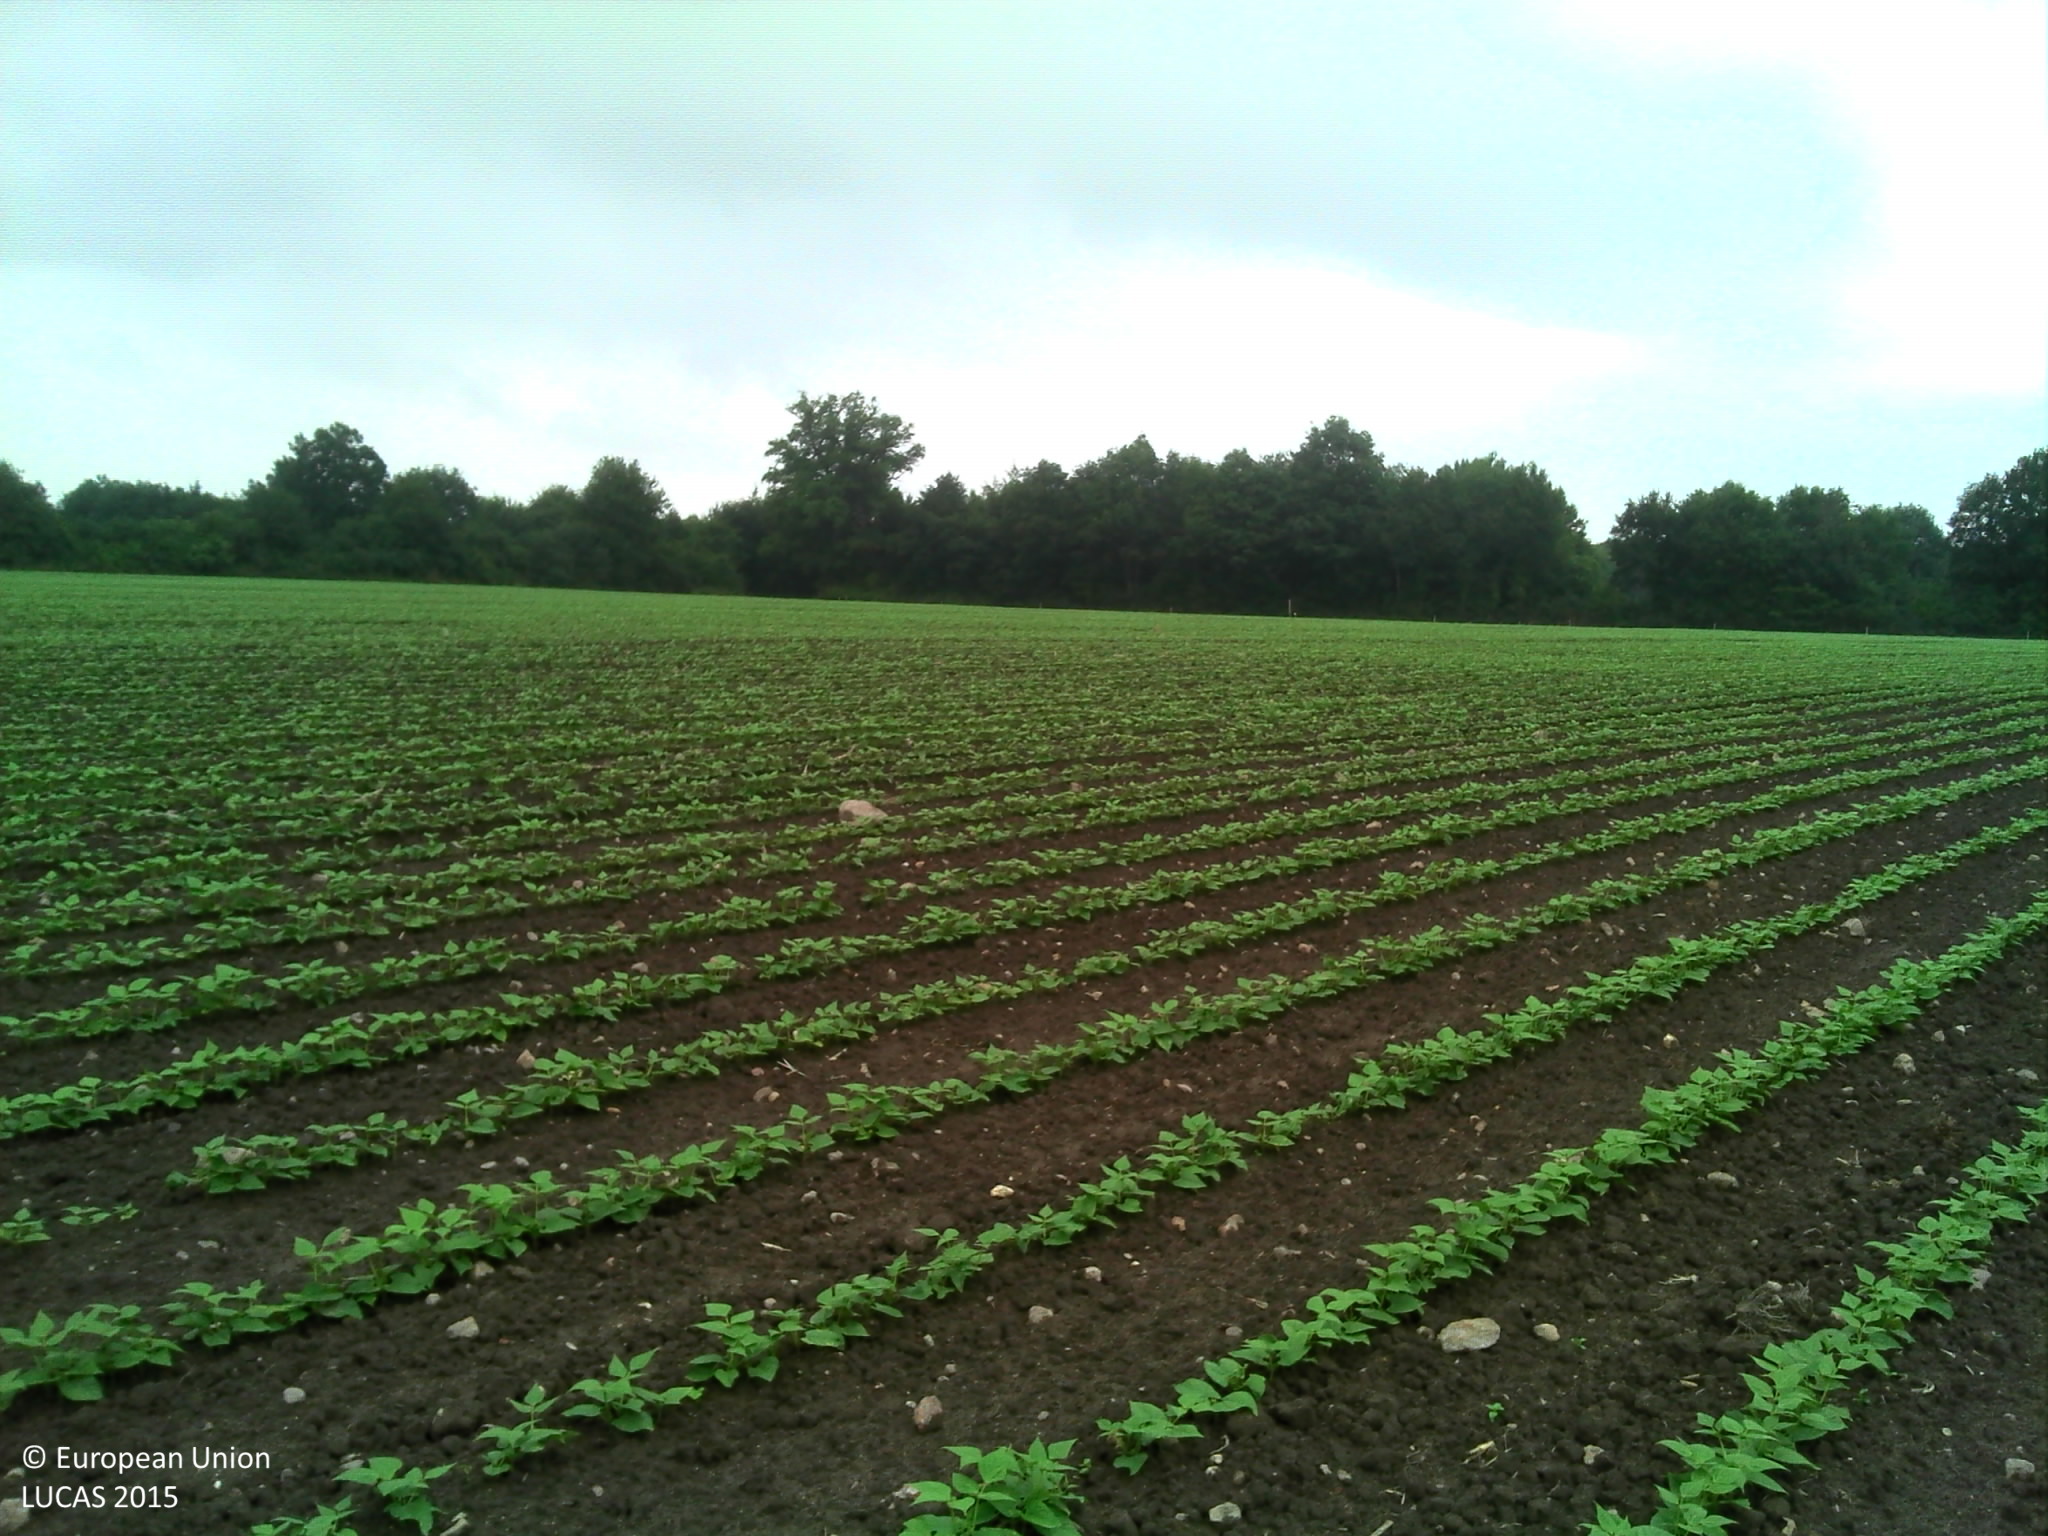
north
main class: Cropland
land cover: Dry pulses
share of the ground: 10 - 25 %
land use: Agriculture (excluding fallow land and kitchen gardens)
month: June
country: FR
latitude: 47.5140
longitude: 0.0016
